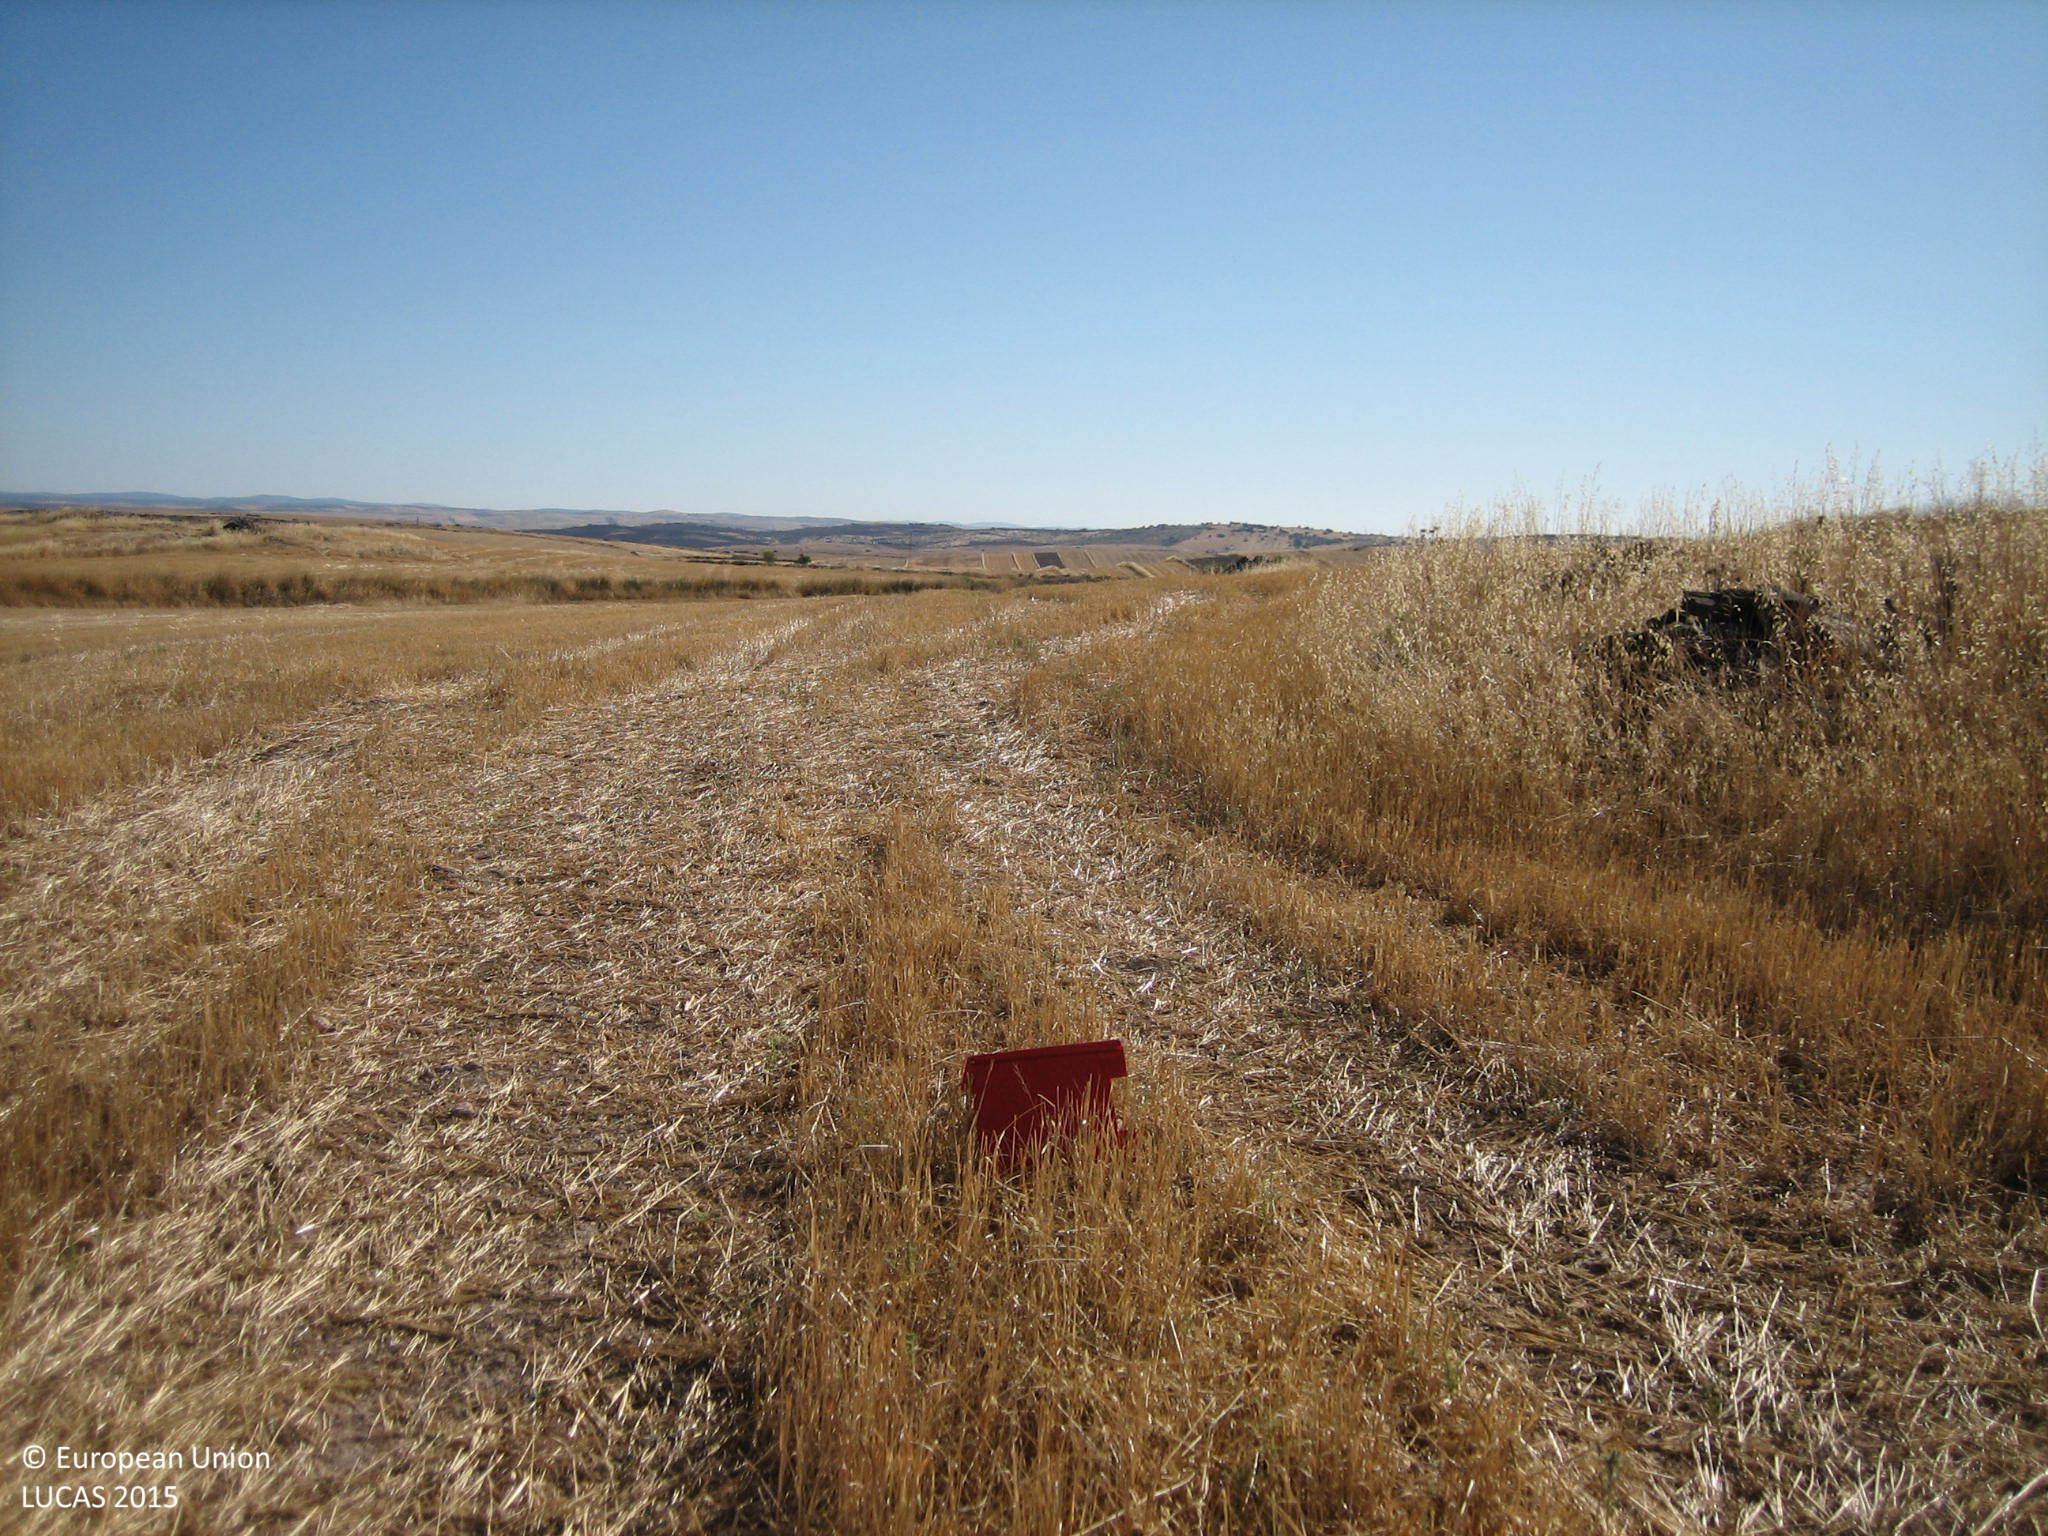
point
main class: Cropland
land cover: Oats
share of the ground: < 10 %
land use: Agriculture (excluding fallow land and kitchen gardens)
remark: Harvested field
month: July
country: ES
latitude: 38.3356
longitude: -6.1169
